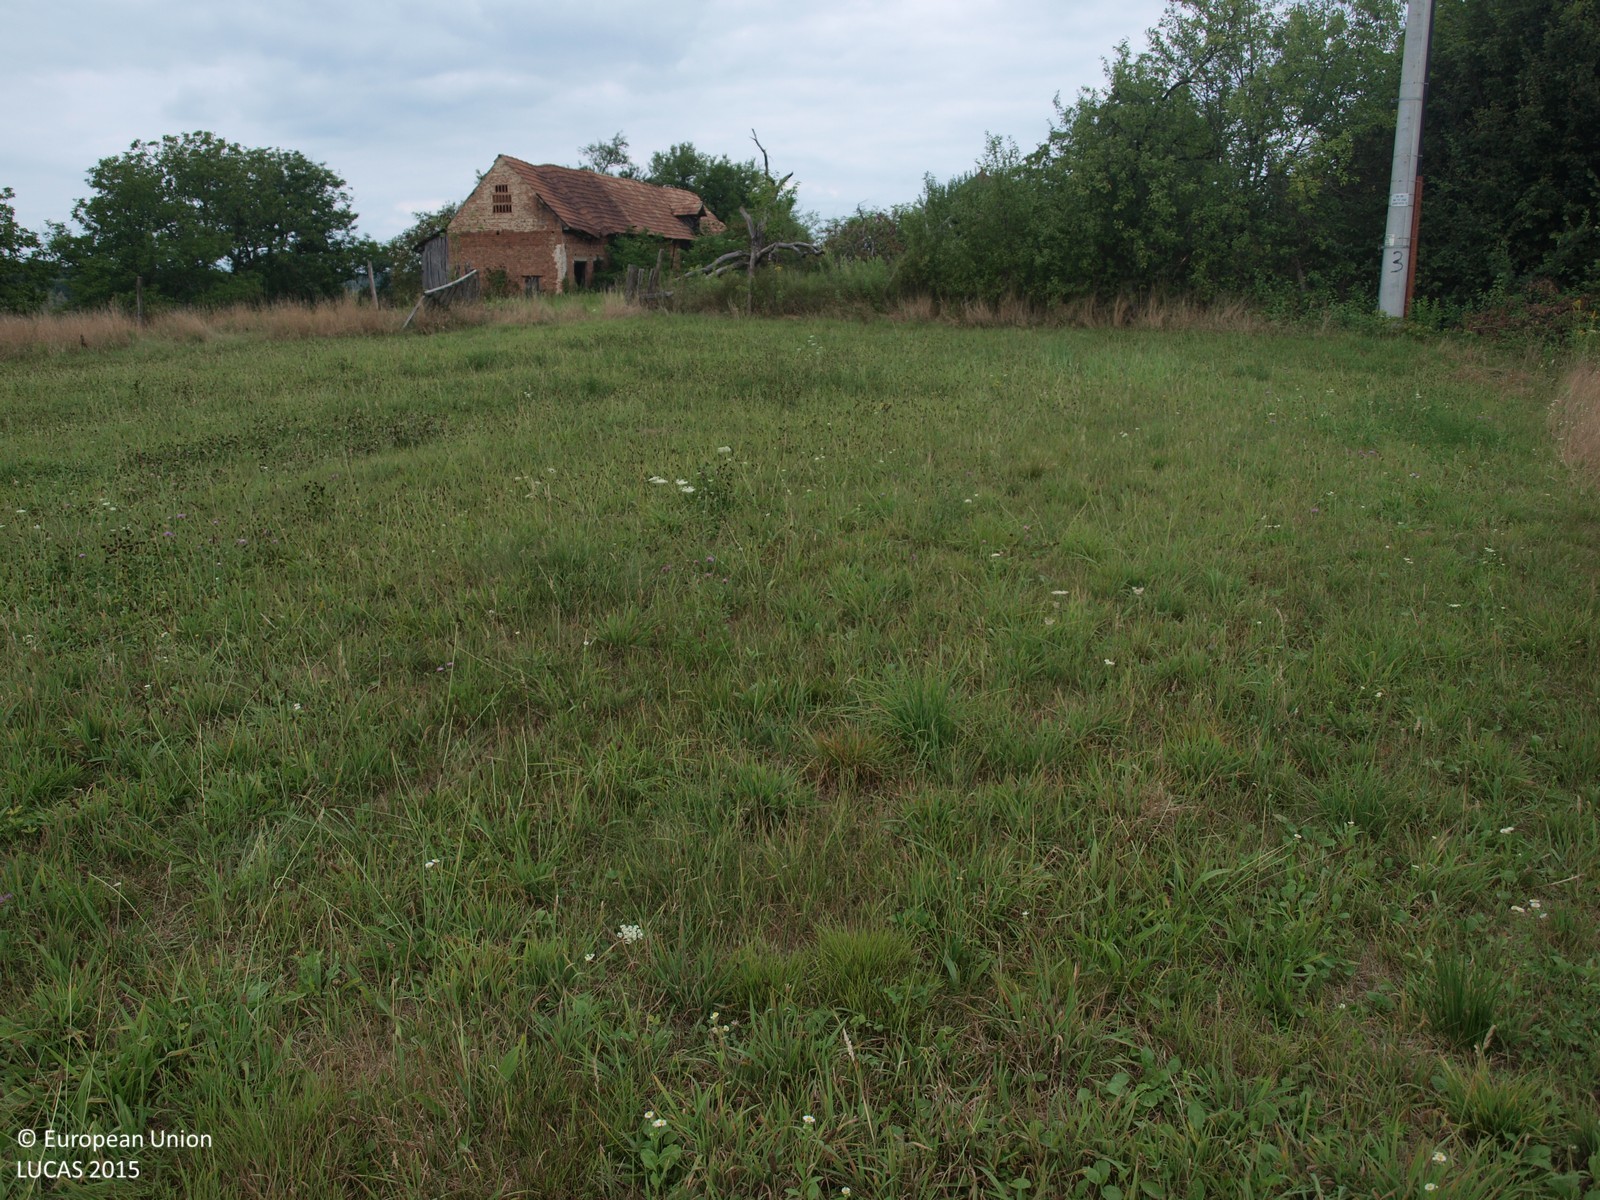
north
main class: Grassland
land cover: Grassland without tree/shrub cover
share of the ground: > 75 %
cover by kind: herbaceous plants 100 %
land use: Agriculture (excluding fallow land and kitchen gardens)
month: August
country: HR
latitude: 45.9467
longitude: 16.3330
